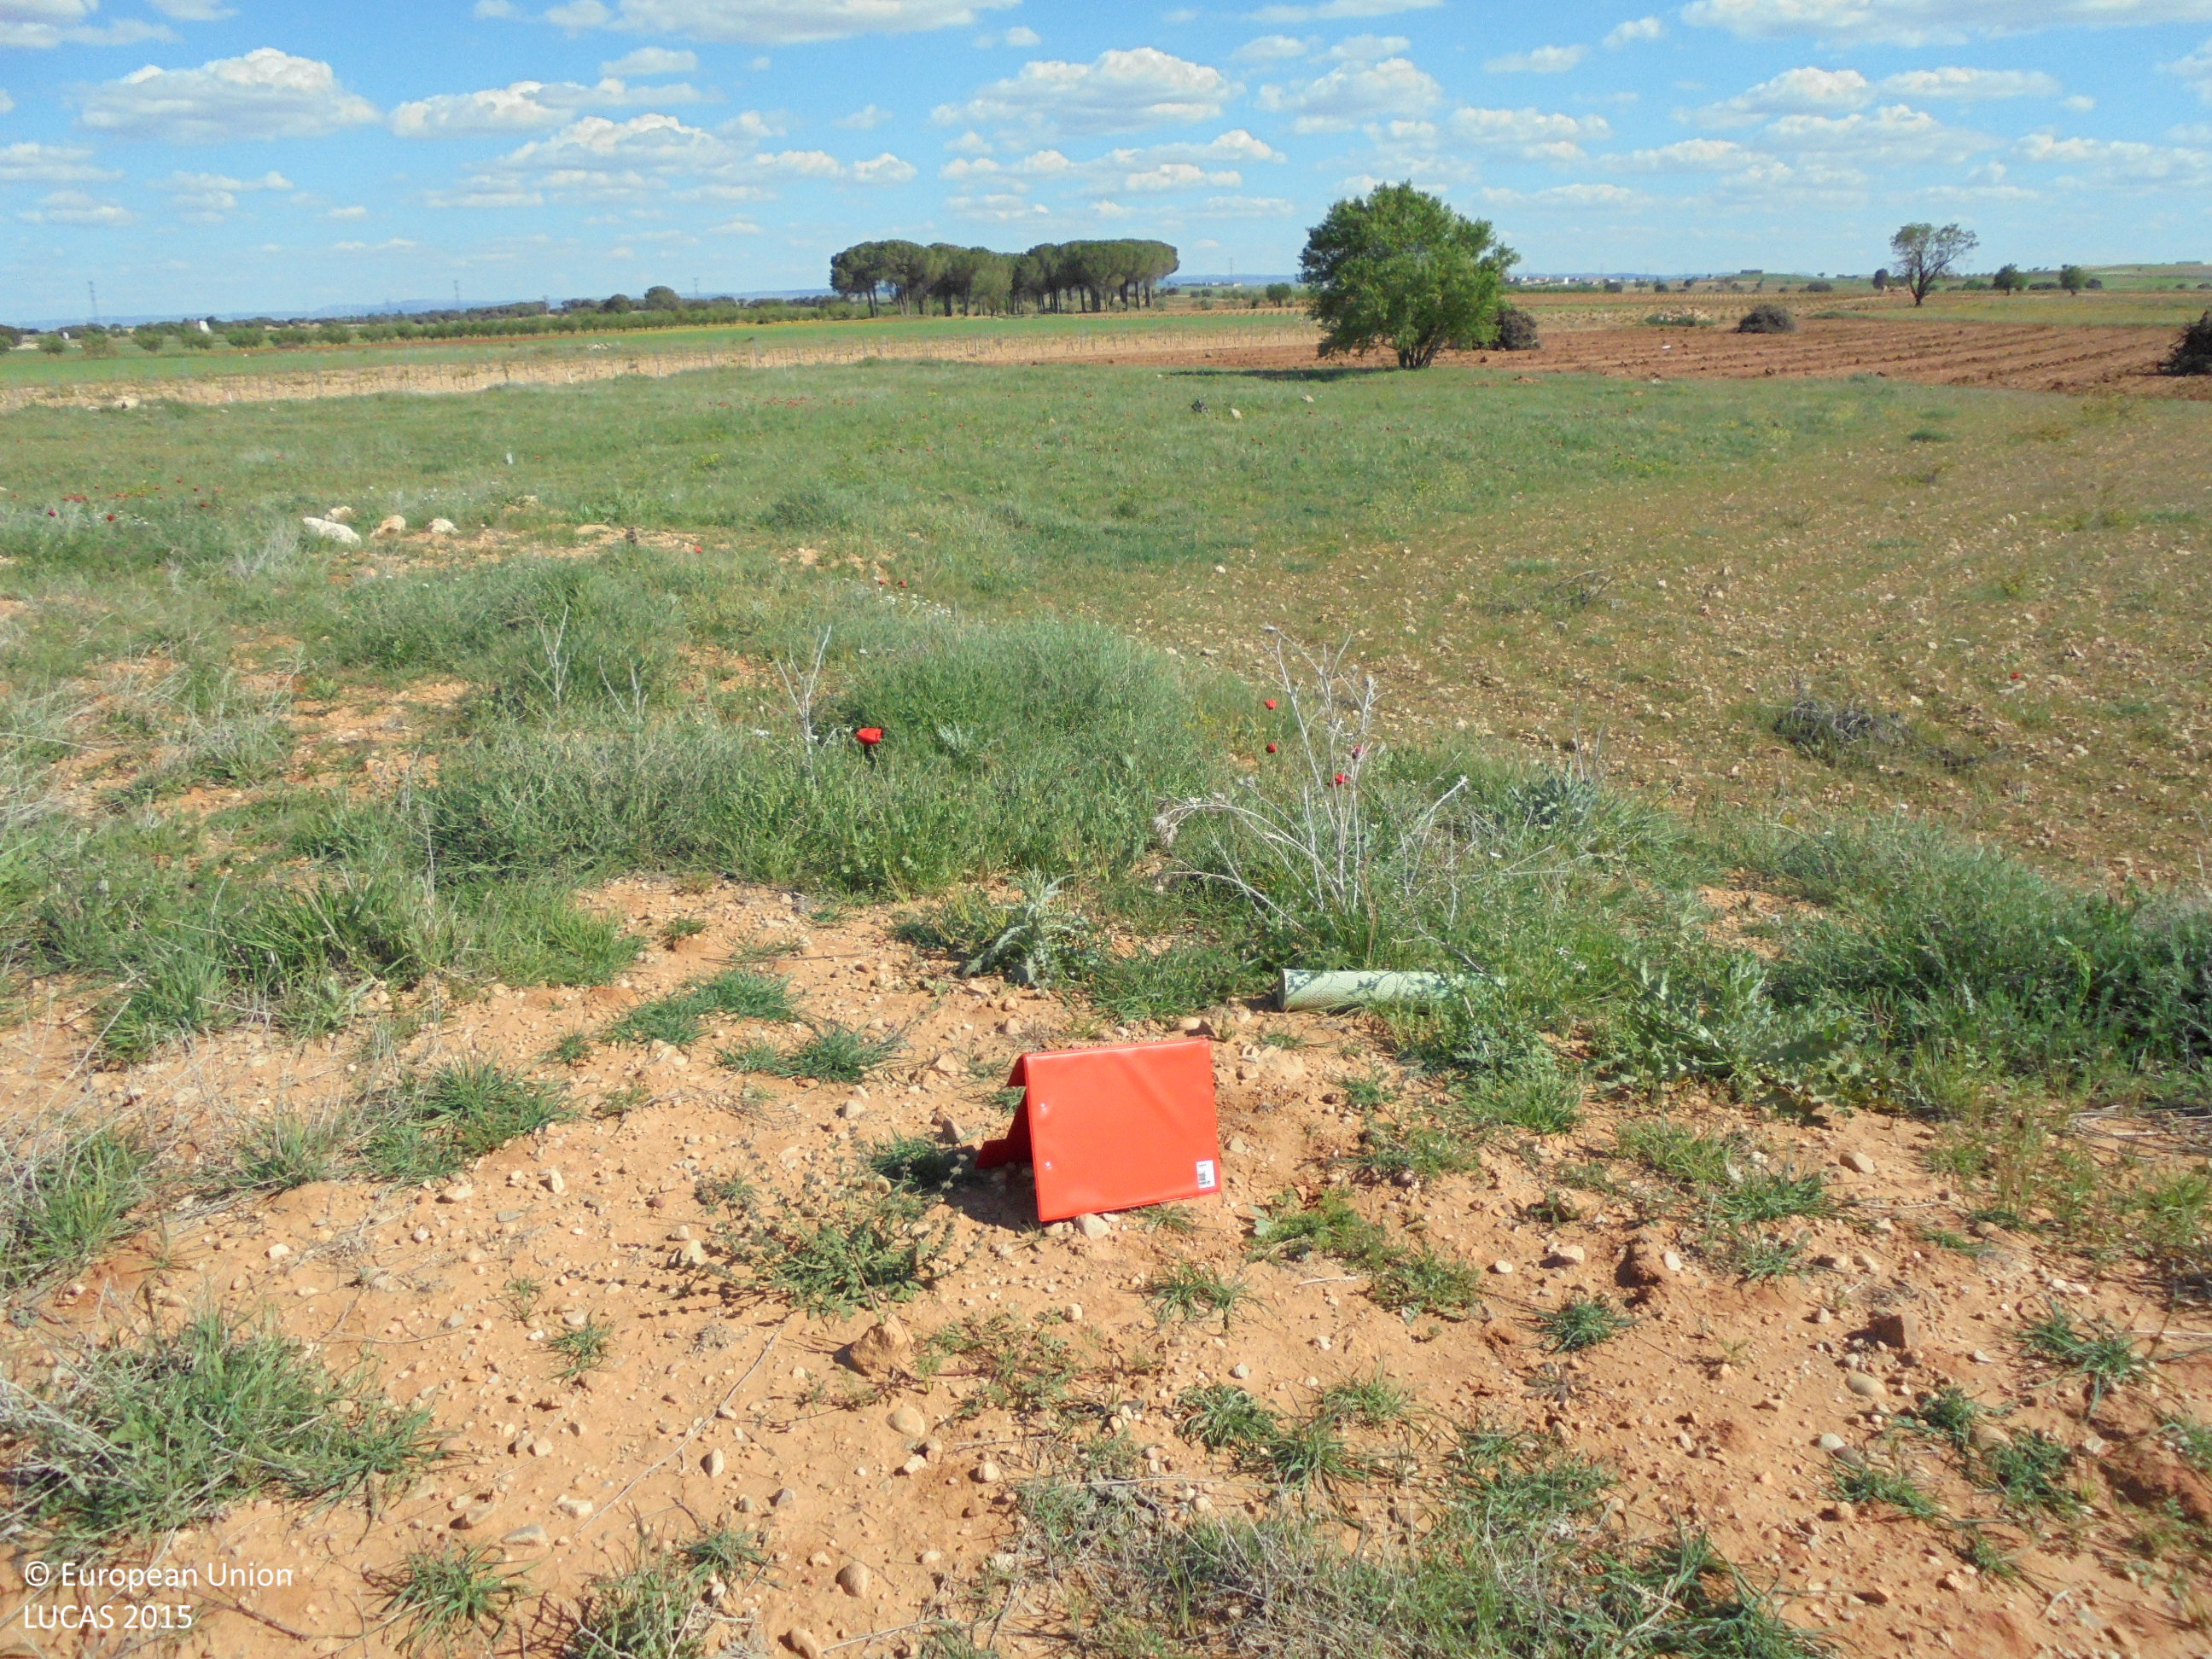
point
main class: Grassland
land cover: Spontaneously vegetated surfaces
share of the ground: 25 - 50 %
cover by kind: herbaceous plants 55 %, unconsolidated bare surface 45 %
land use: Abandoned areas
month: April
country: ES
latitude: 39.2051
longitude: -1.8029
